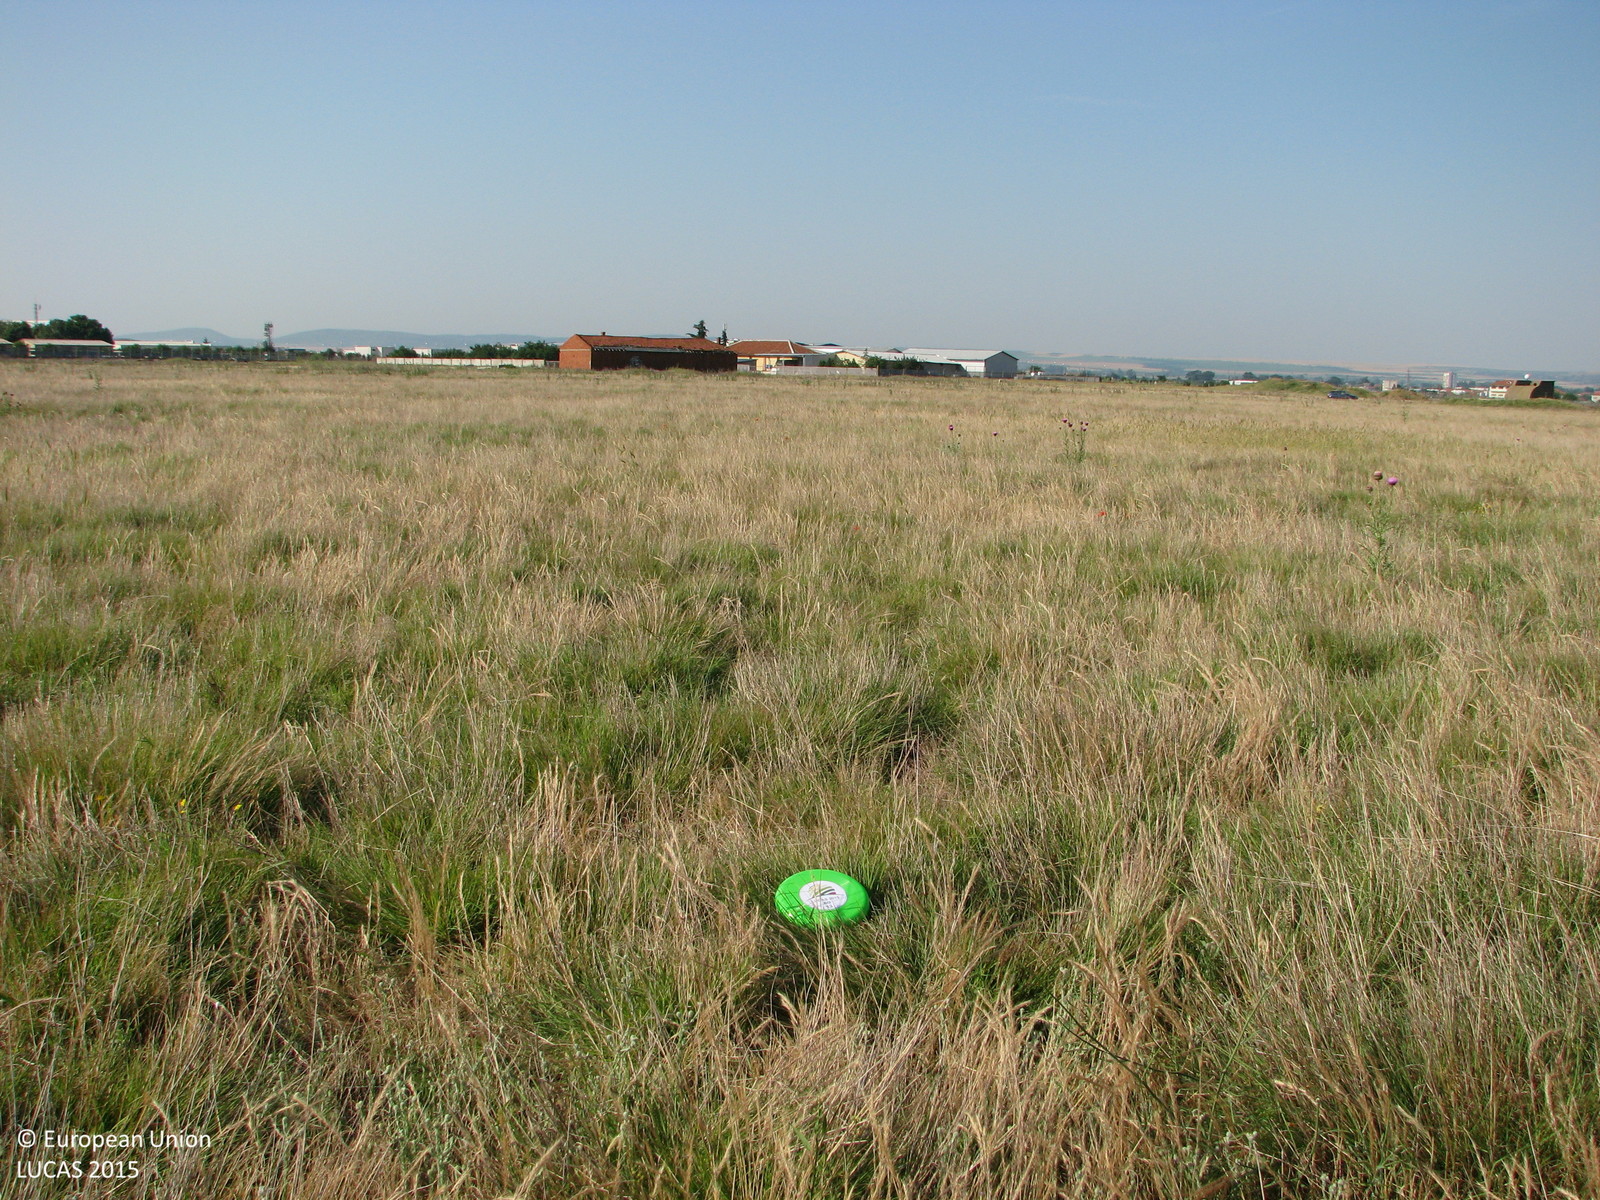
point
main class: Grassland
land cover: Grassland without tree/shrub cover
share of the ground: > 75 %
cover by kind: herbaceous plants 100 %
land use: Agriculture (excluding fallow land and kitchen gardens)
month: June
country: BG
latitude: 42.6470
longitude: 26.2995
